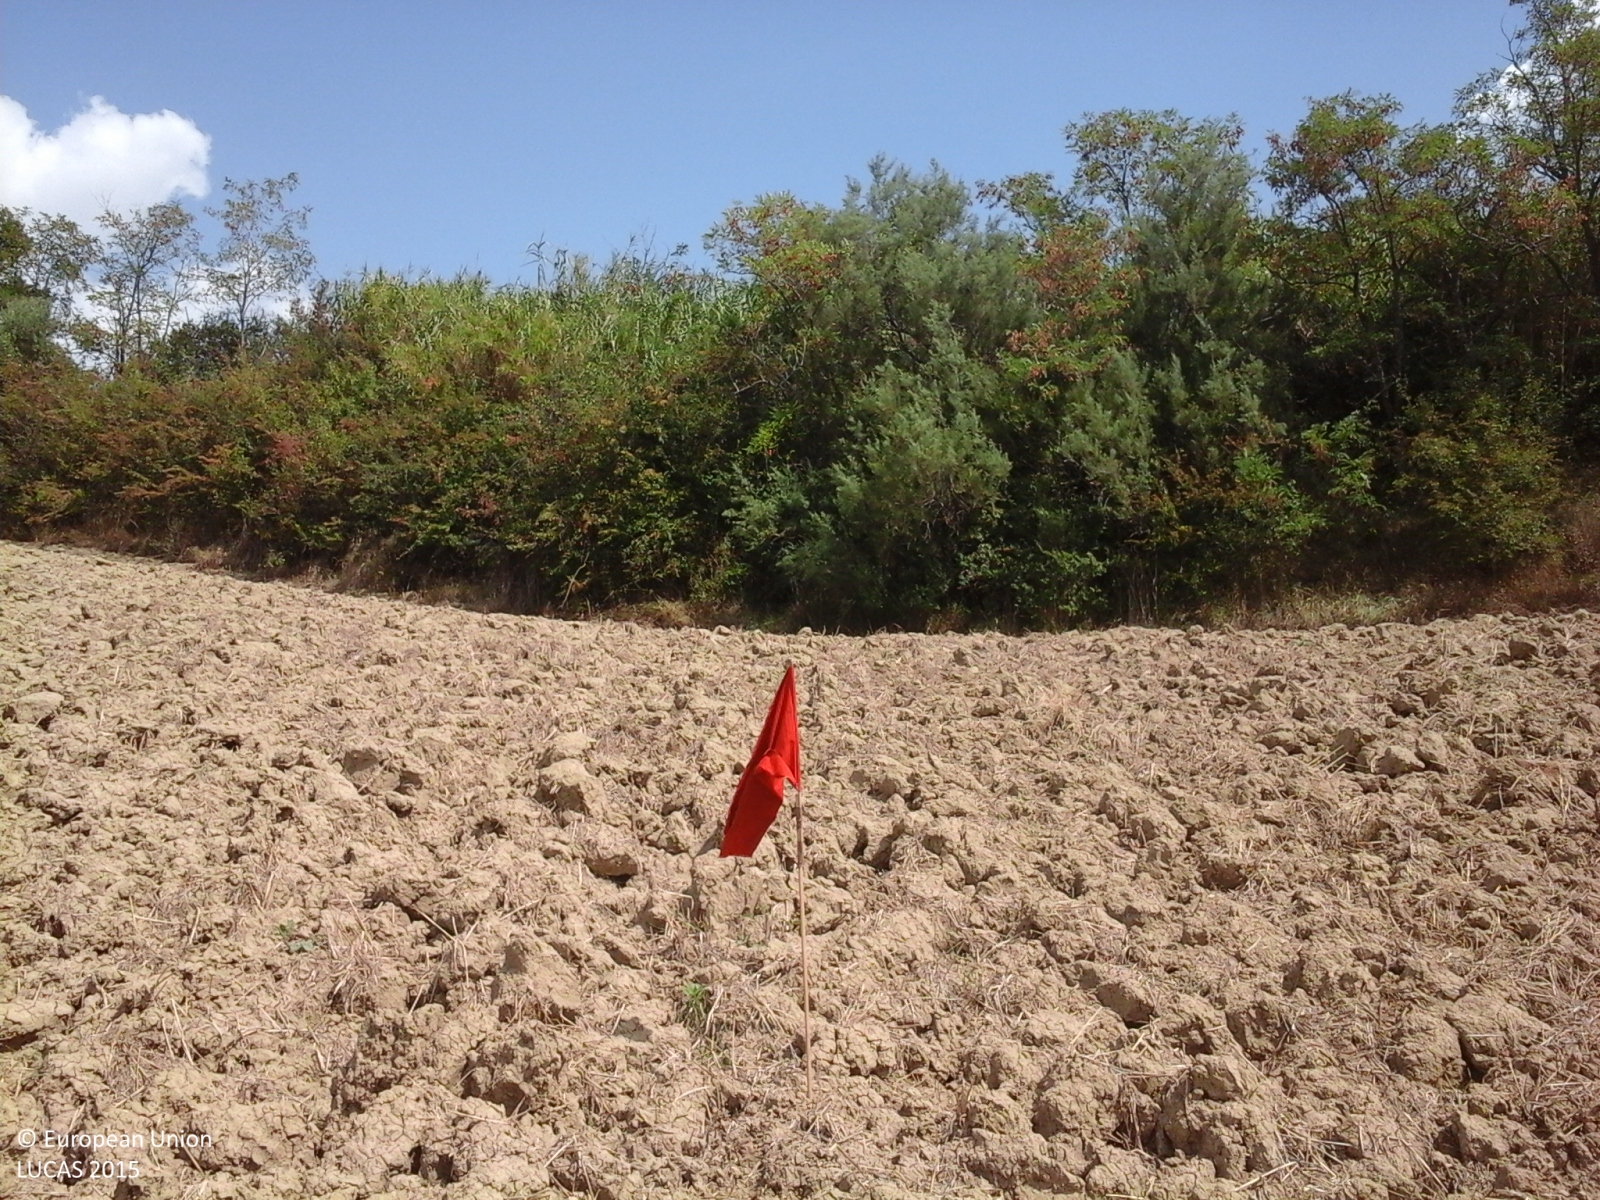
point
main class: Cropland
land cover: Durum wheat
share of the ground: < 10 %
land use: Agriculture (excluding fallow land and kitchen gardens)
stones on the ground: 10 - 25 %
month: August
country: IT
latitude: 43.3972
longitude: 13.2389
